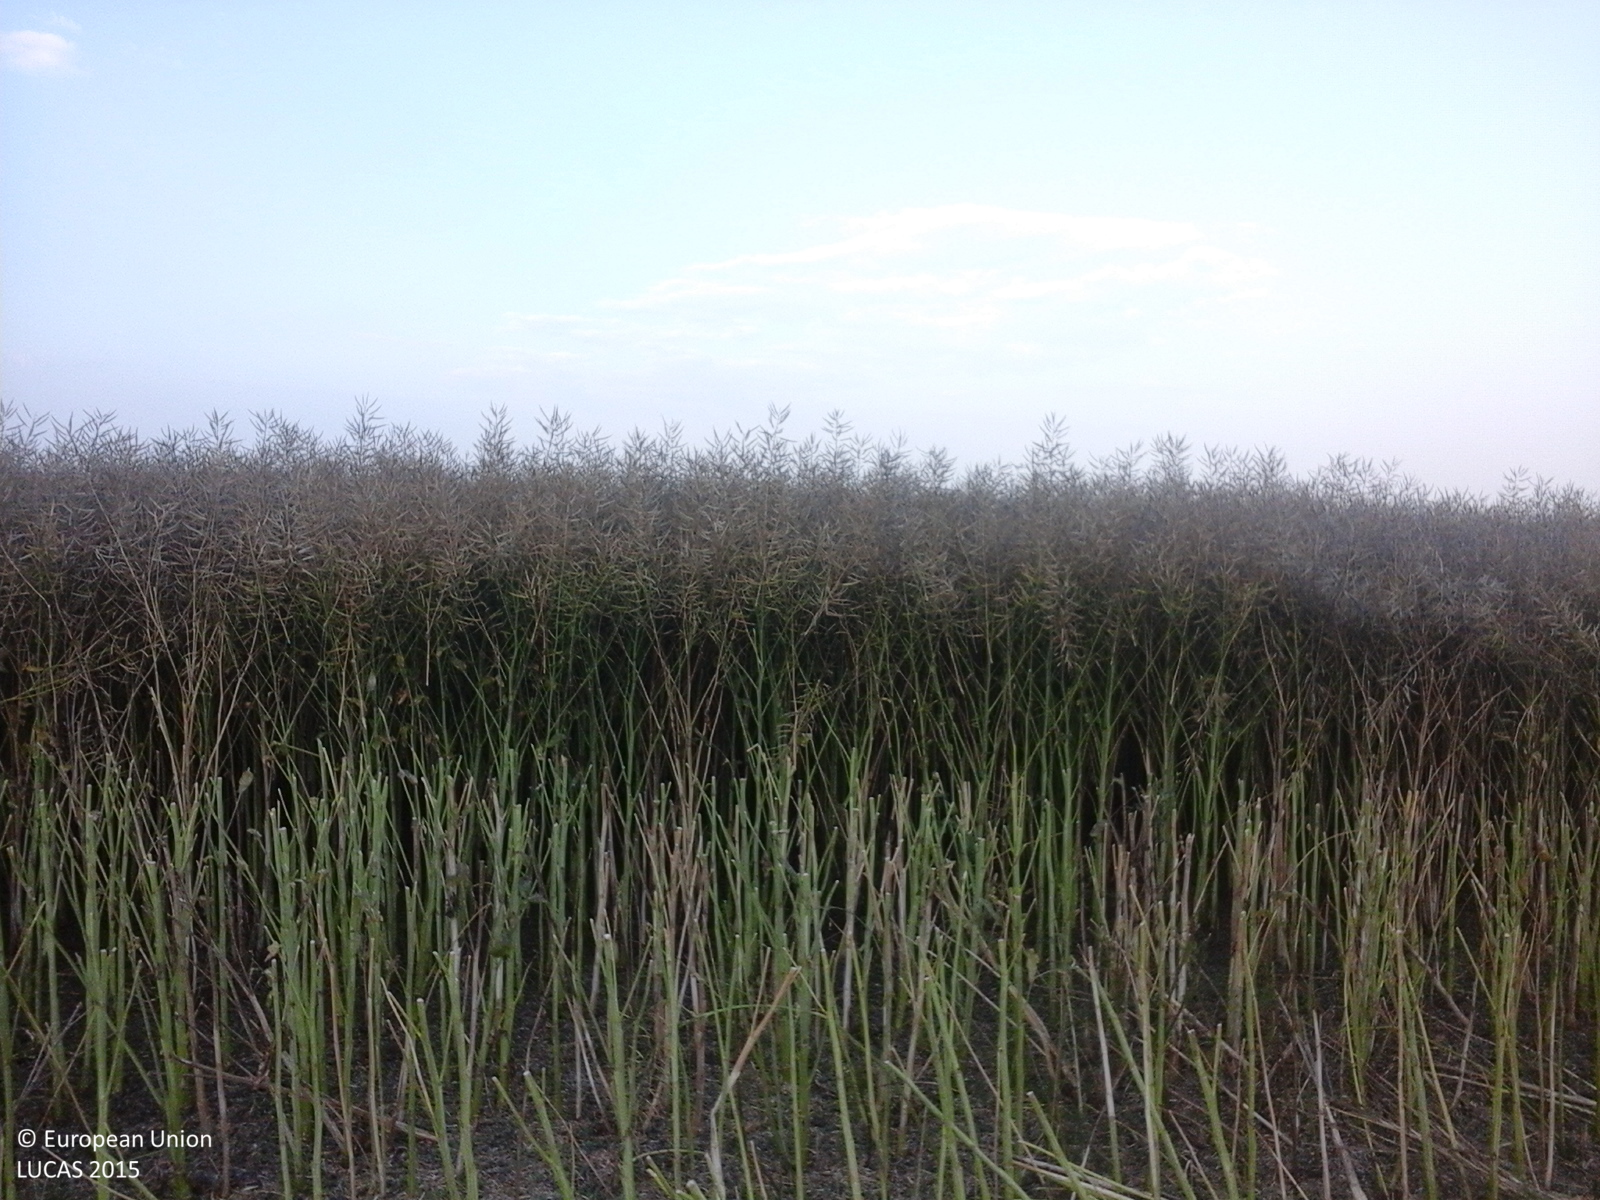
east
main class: Cropland
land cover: Rape and turnip rape
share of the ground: > 75 %
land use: Agriculture (excluding fallow land and kitchen gardens)
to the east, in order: Rape and turnip rape
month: July
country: RO
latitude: 43.9472
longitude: 24.7611
